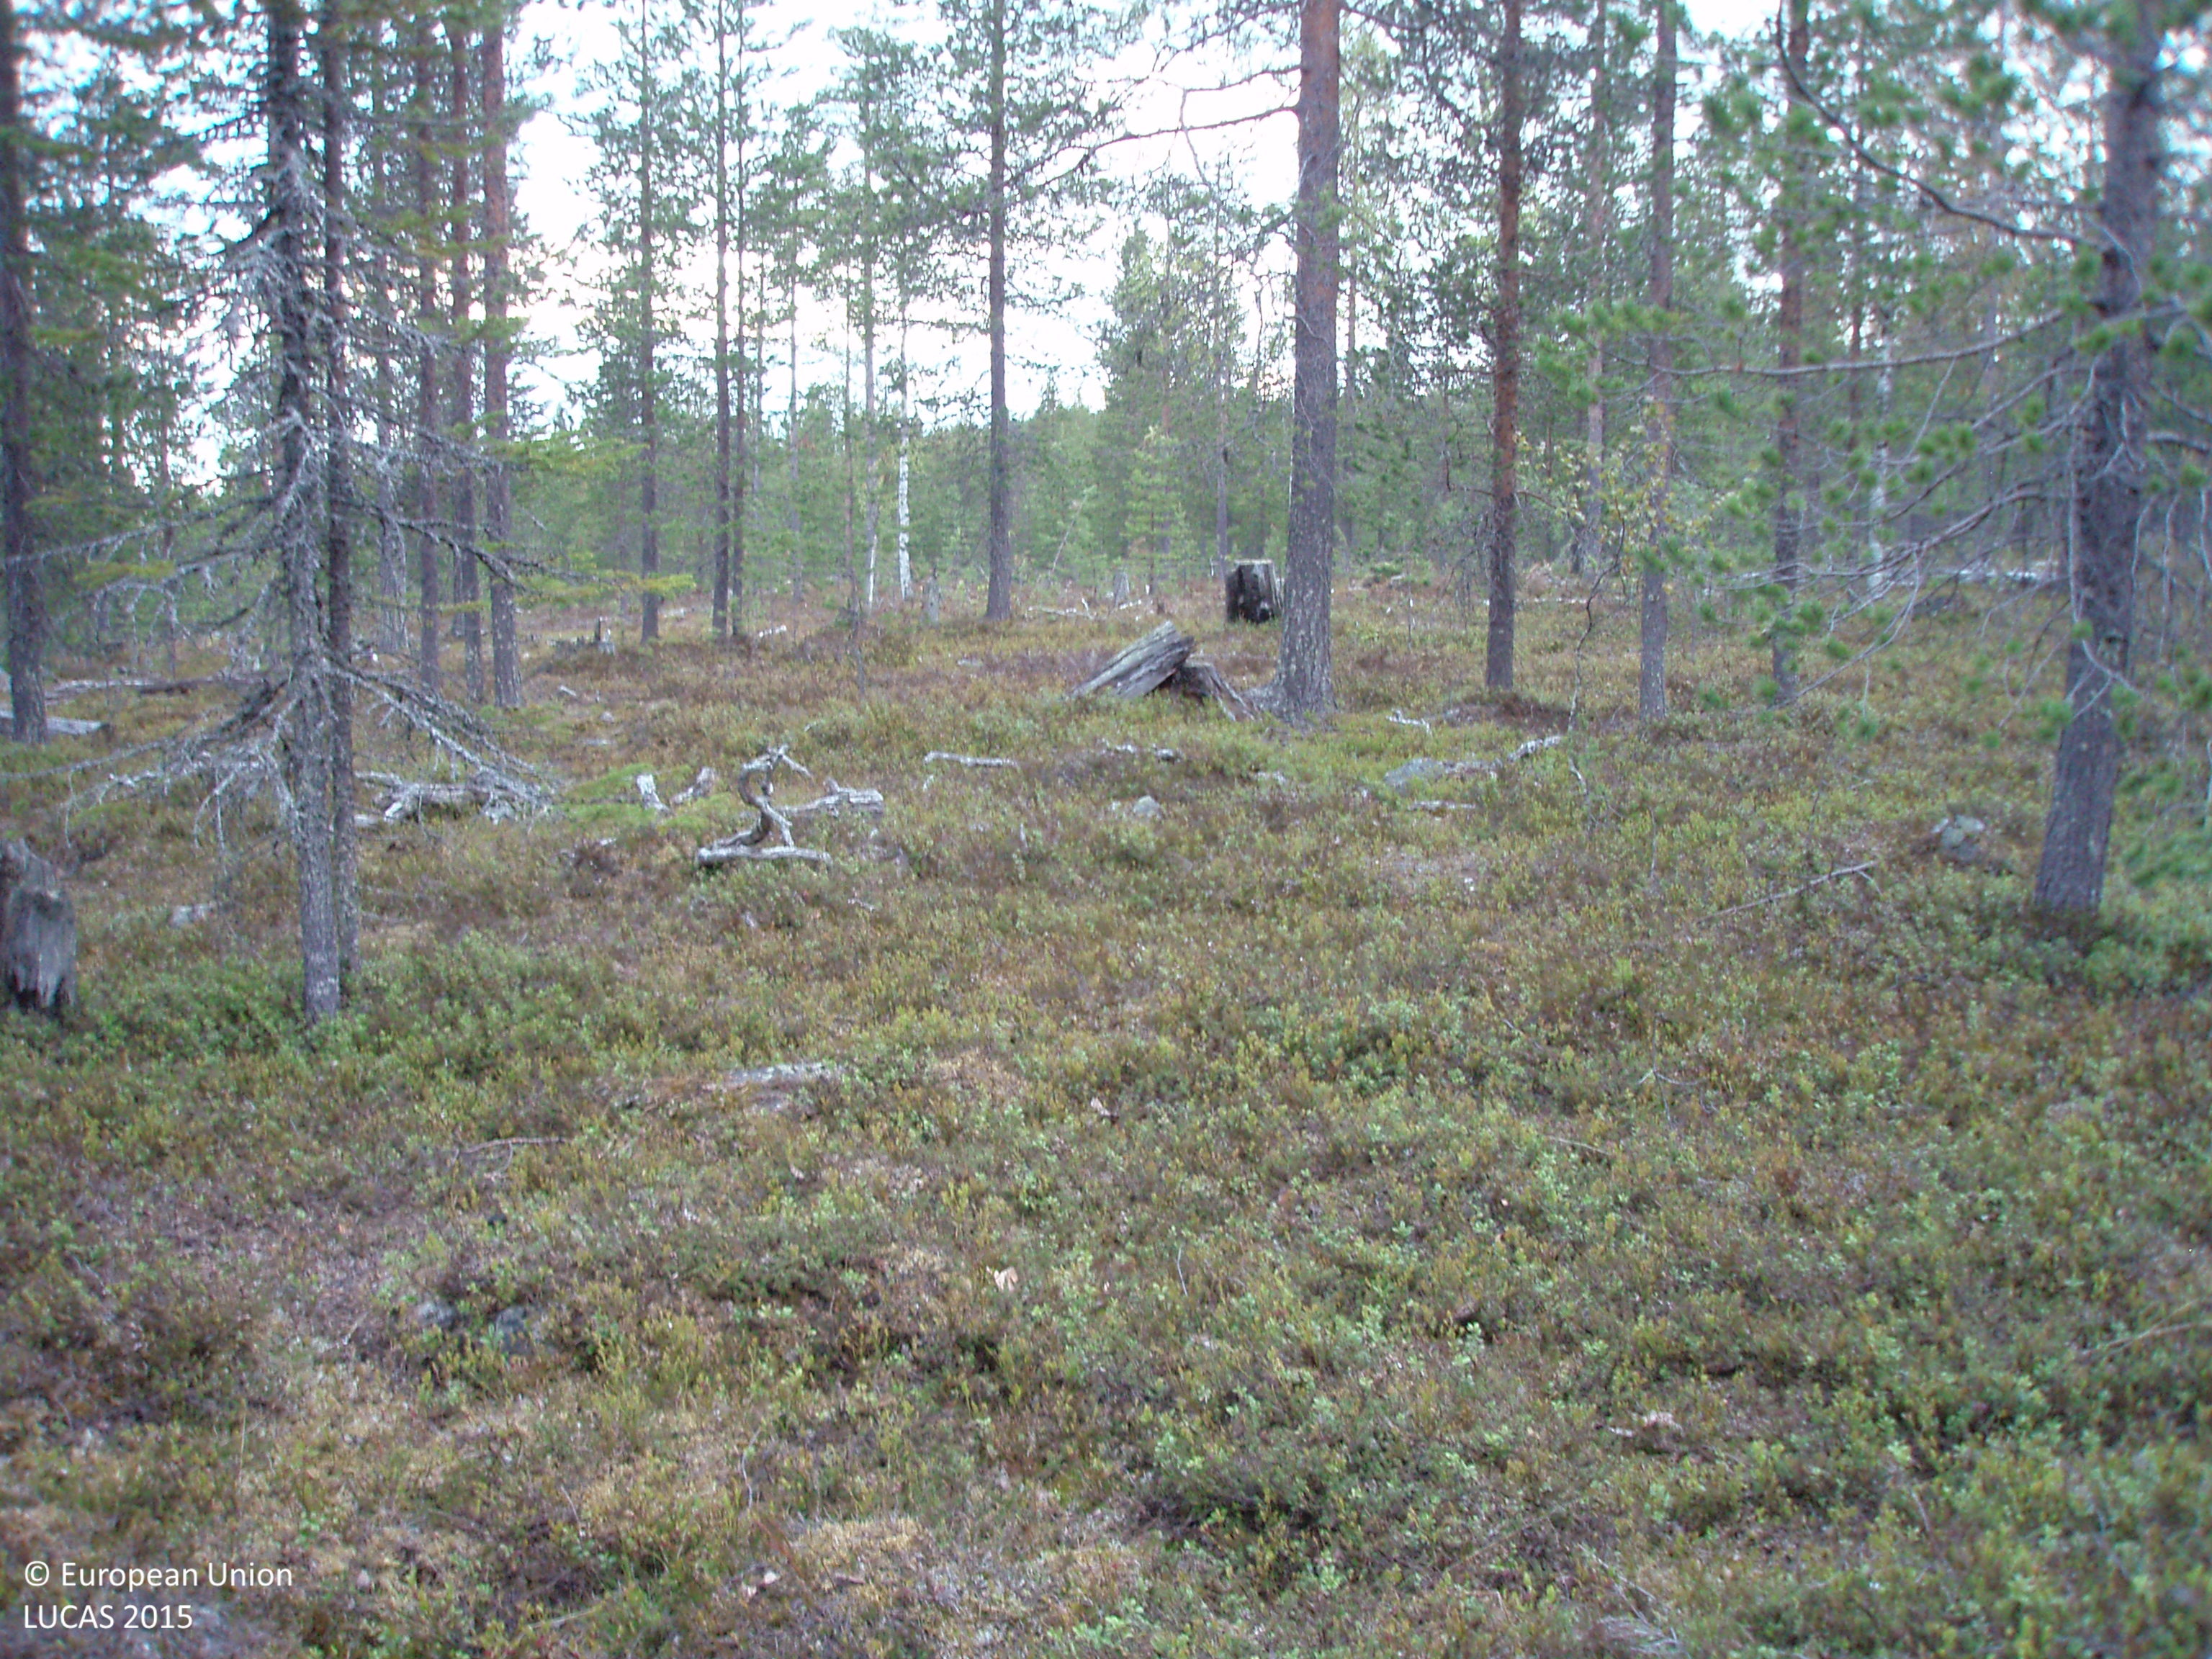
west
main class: Woodland
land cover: Pine dominated coniferous woodland
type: boreal forest
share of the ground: 50 - 75 %
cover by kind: coniferous forest trees 50 %, shrubs 45 %, broadleaved forest trees 5 %
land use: Forestry
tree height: > 5 m
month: June
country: FI
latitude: 67.3598
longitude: 27.0105
